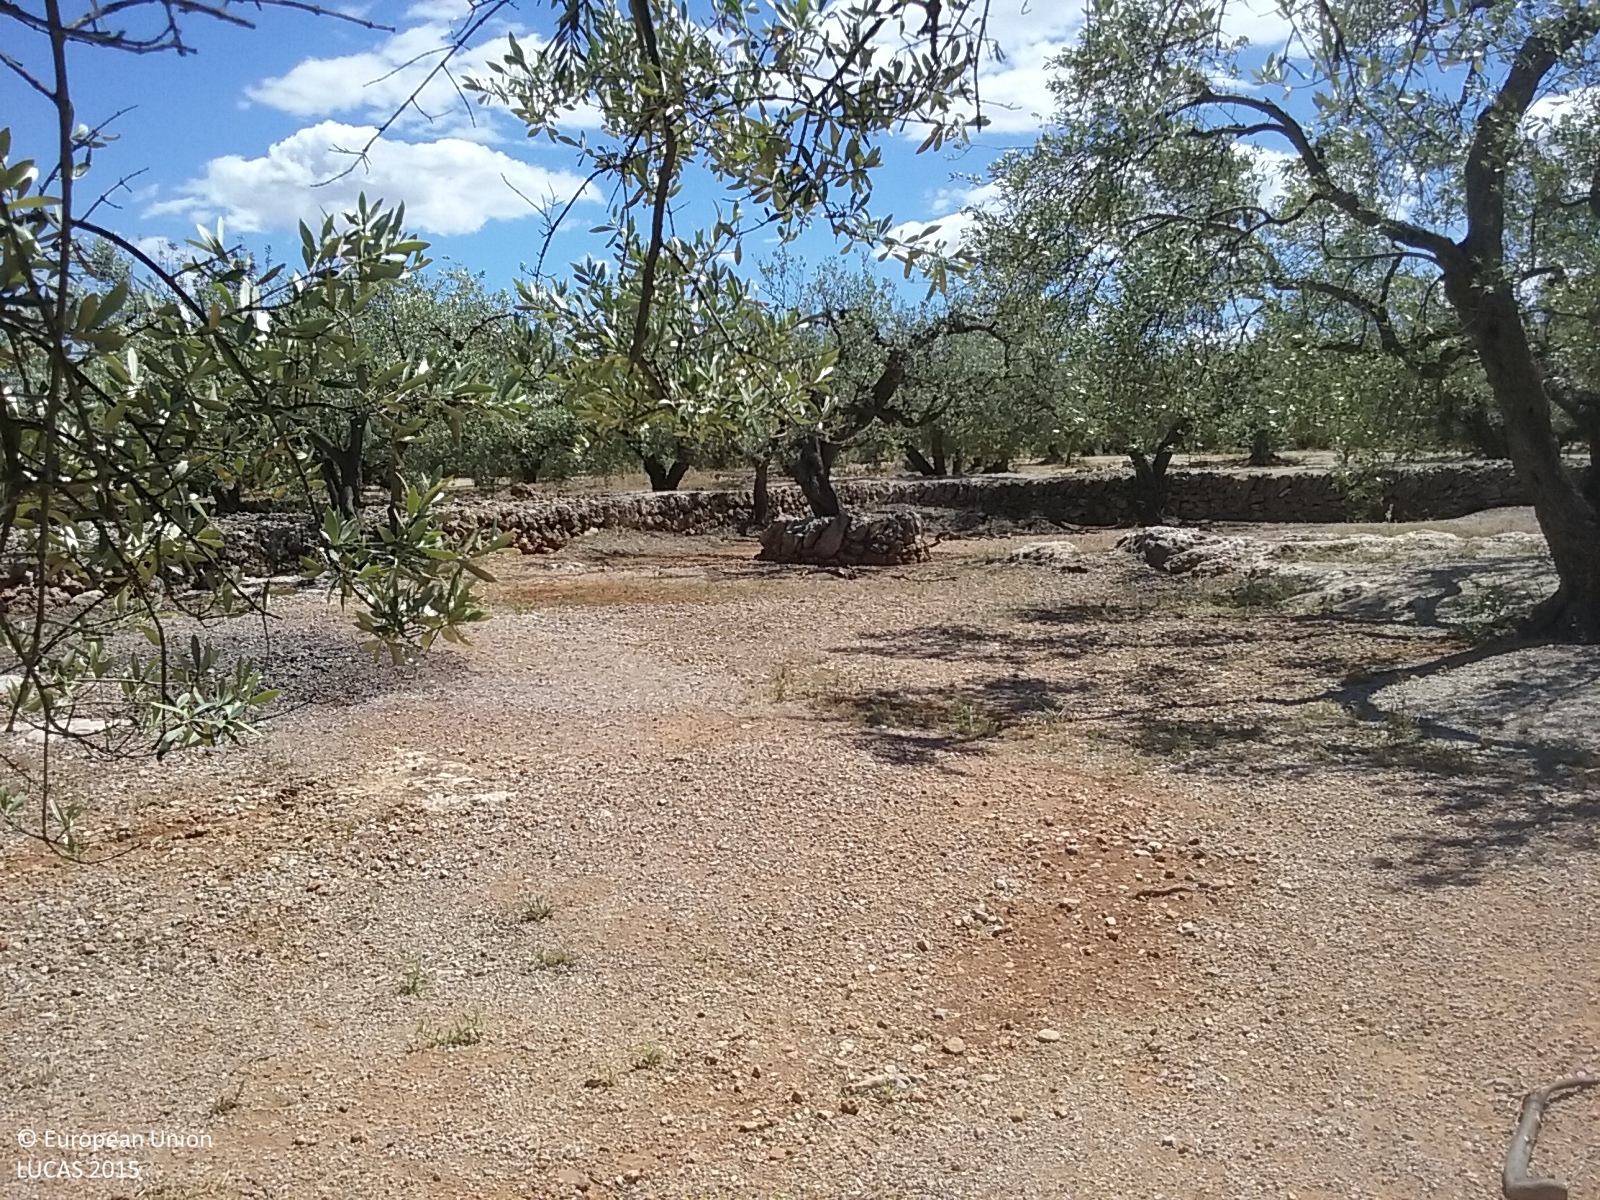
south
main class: Cropland
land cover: Olive groves
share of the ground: 50 - 75 %
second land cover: Other bare soil
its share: > 75 %
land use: Agriculture (excluding fallow land and kitchen gardens)
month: May
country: ES
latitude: 40.7232
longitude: 0.3926
